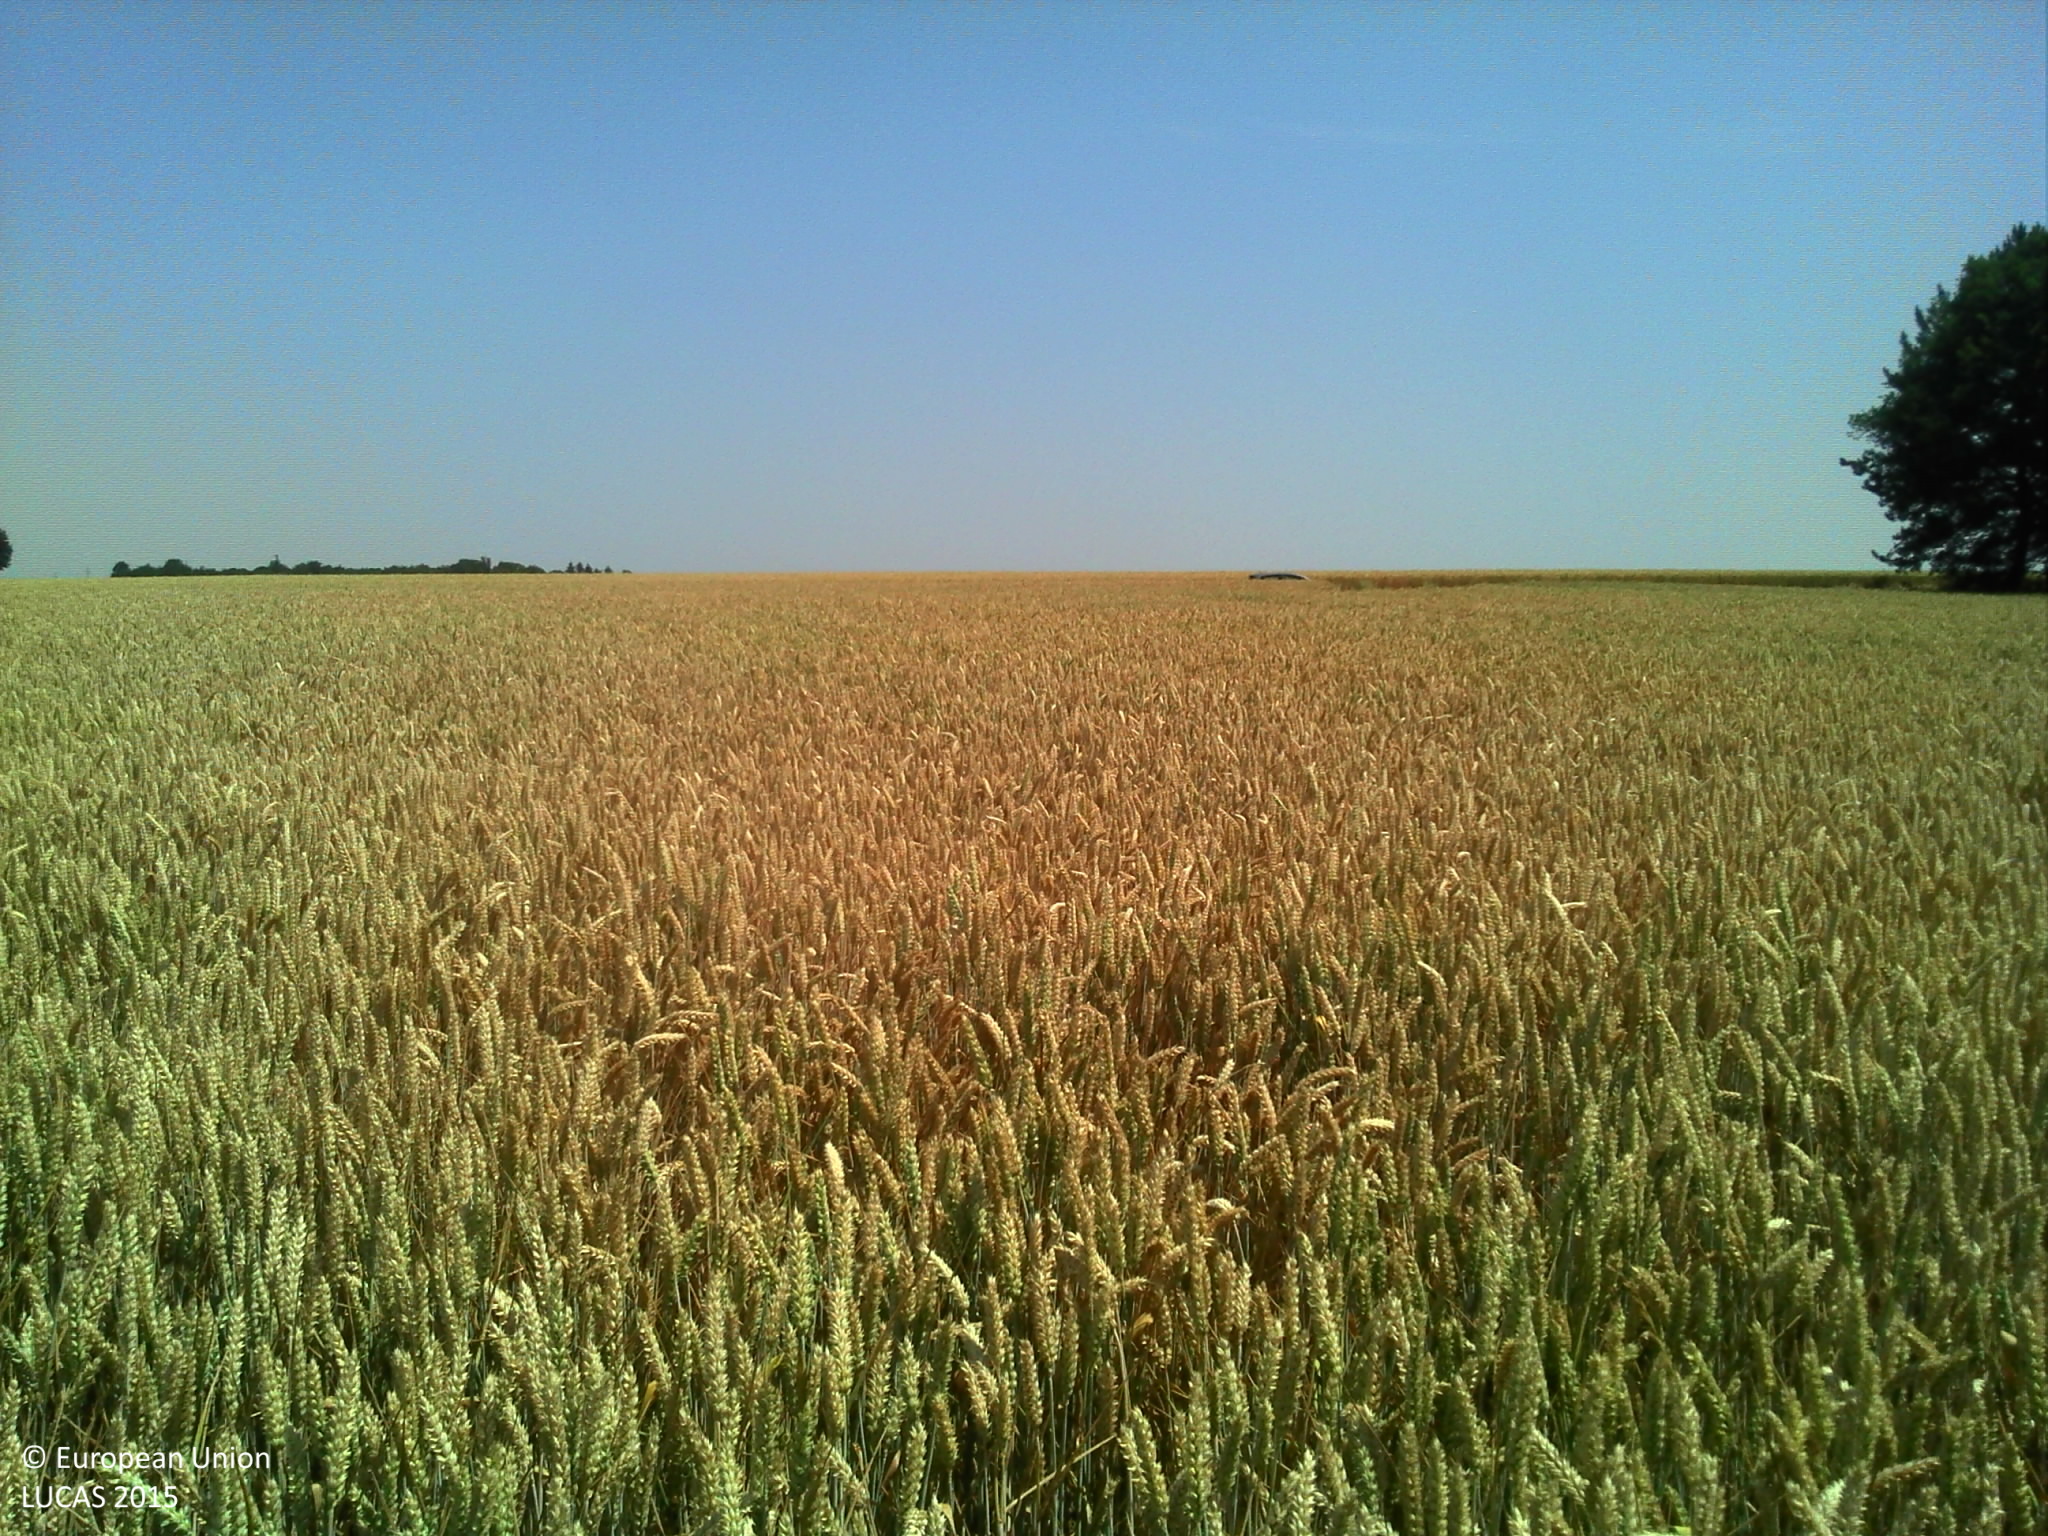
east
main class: Cropland
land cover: Common wheat
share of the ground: > 75 %
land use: Agriculture (excluding fallow land and kitchen gardens)
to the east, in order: Common wheat; Grass margins; Paved roads, cycling and walking lanes; Grass margins; Common wheat
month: July
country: FR
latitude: 48.9211
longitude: 1.2050
